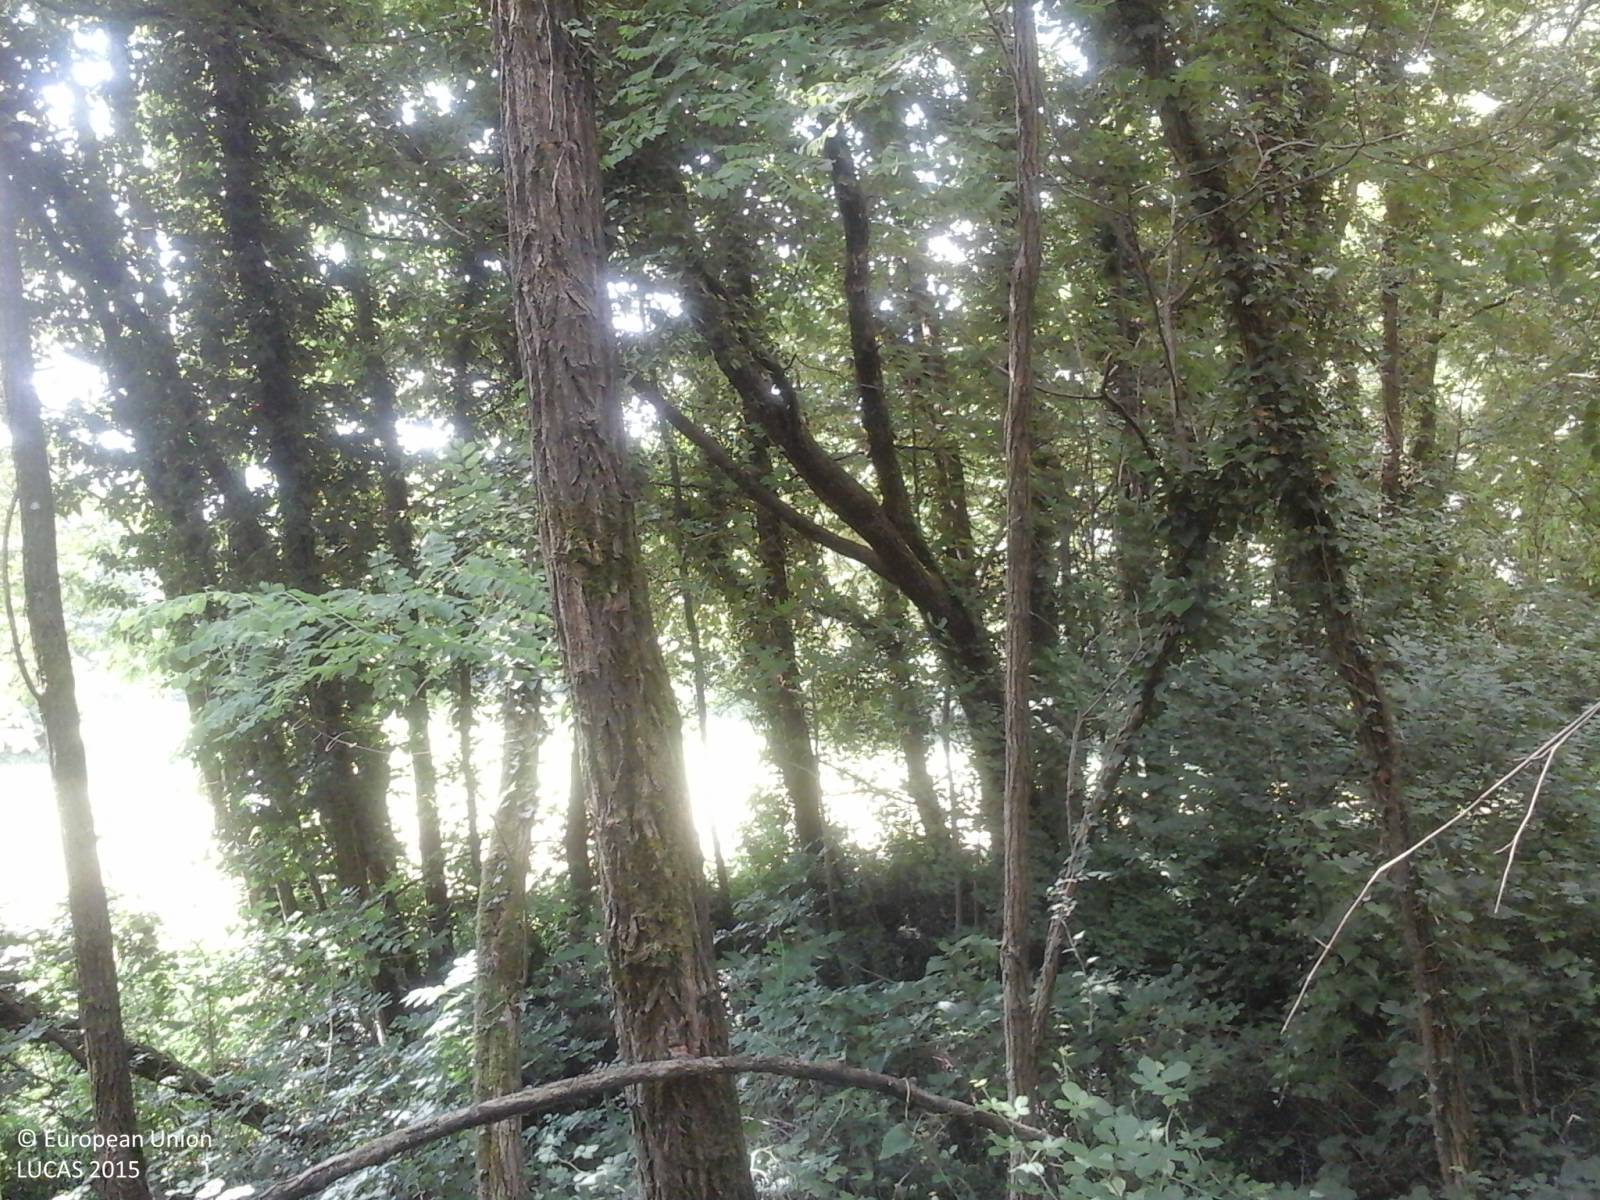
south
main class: Woodland
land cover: Broadleaved woodland
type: exotic forest
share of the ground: > 75 %
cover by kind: broadleaved forest trees 80 %, shrubs 20 %
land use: Forestry
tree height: > 5 m
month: June
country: IT
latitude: 46.0861
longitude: 12.5704
